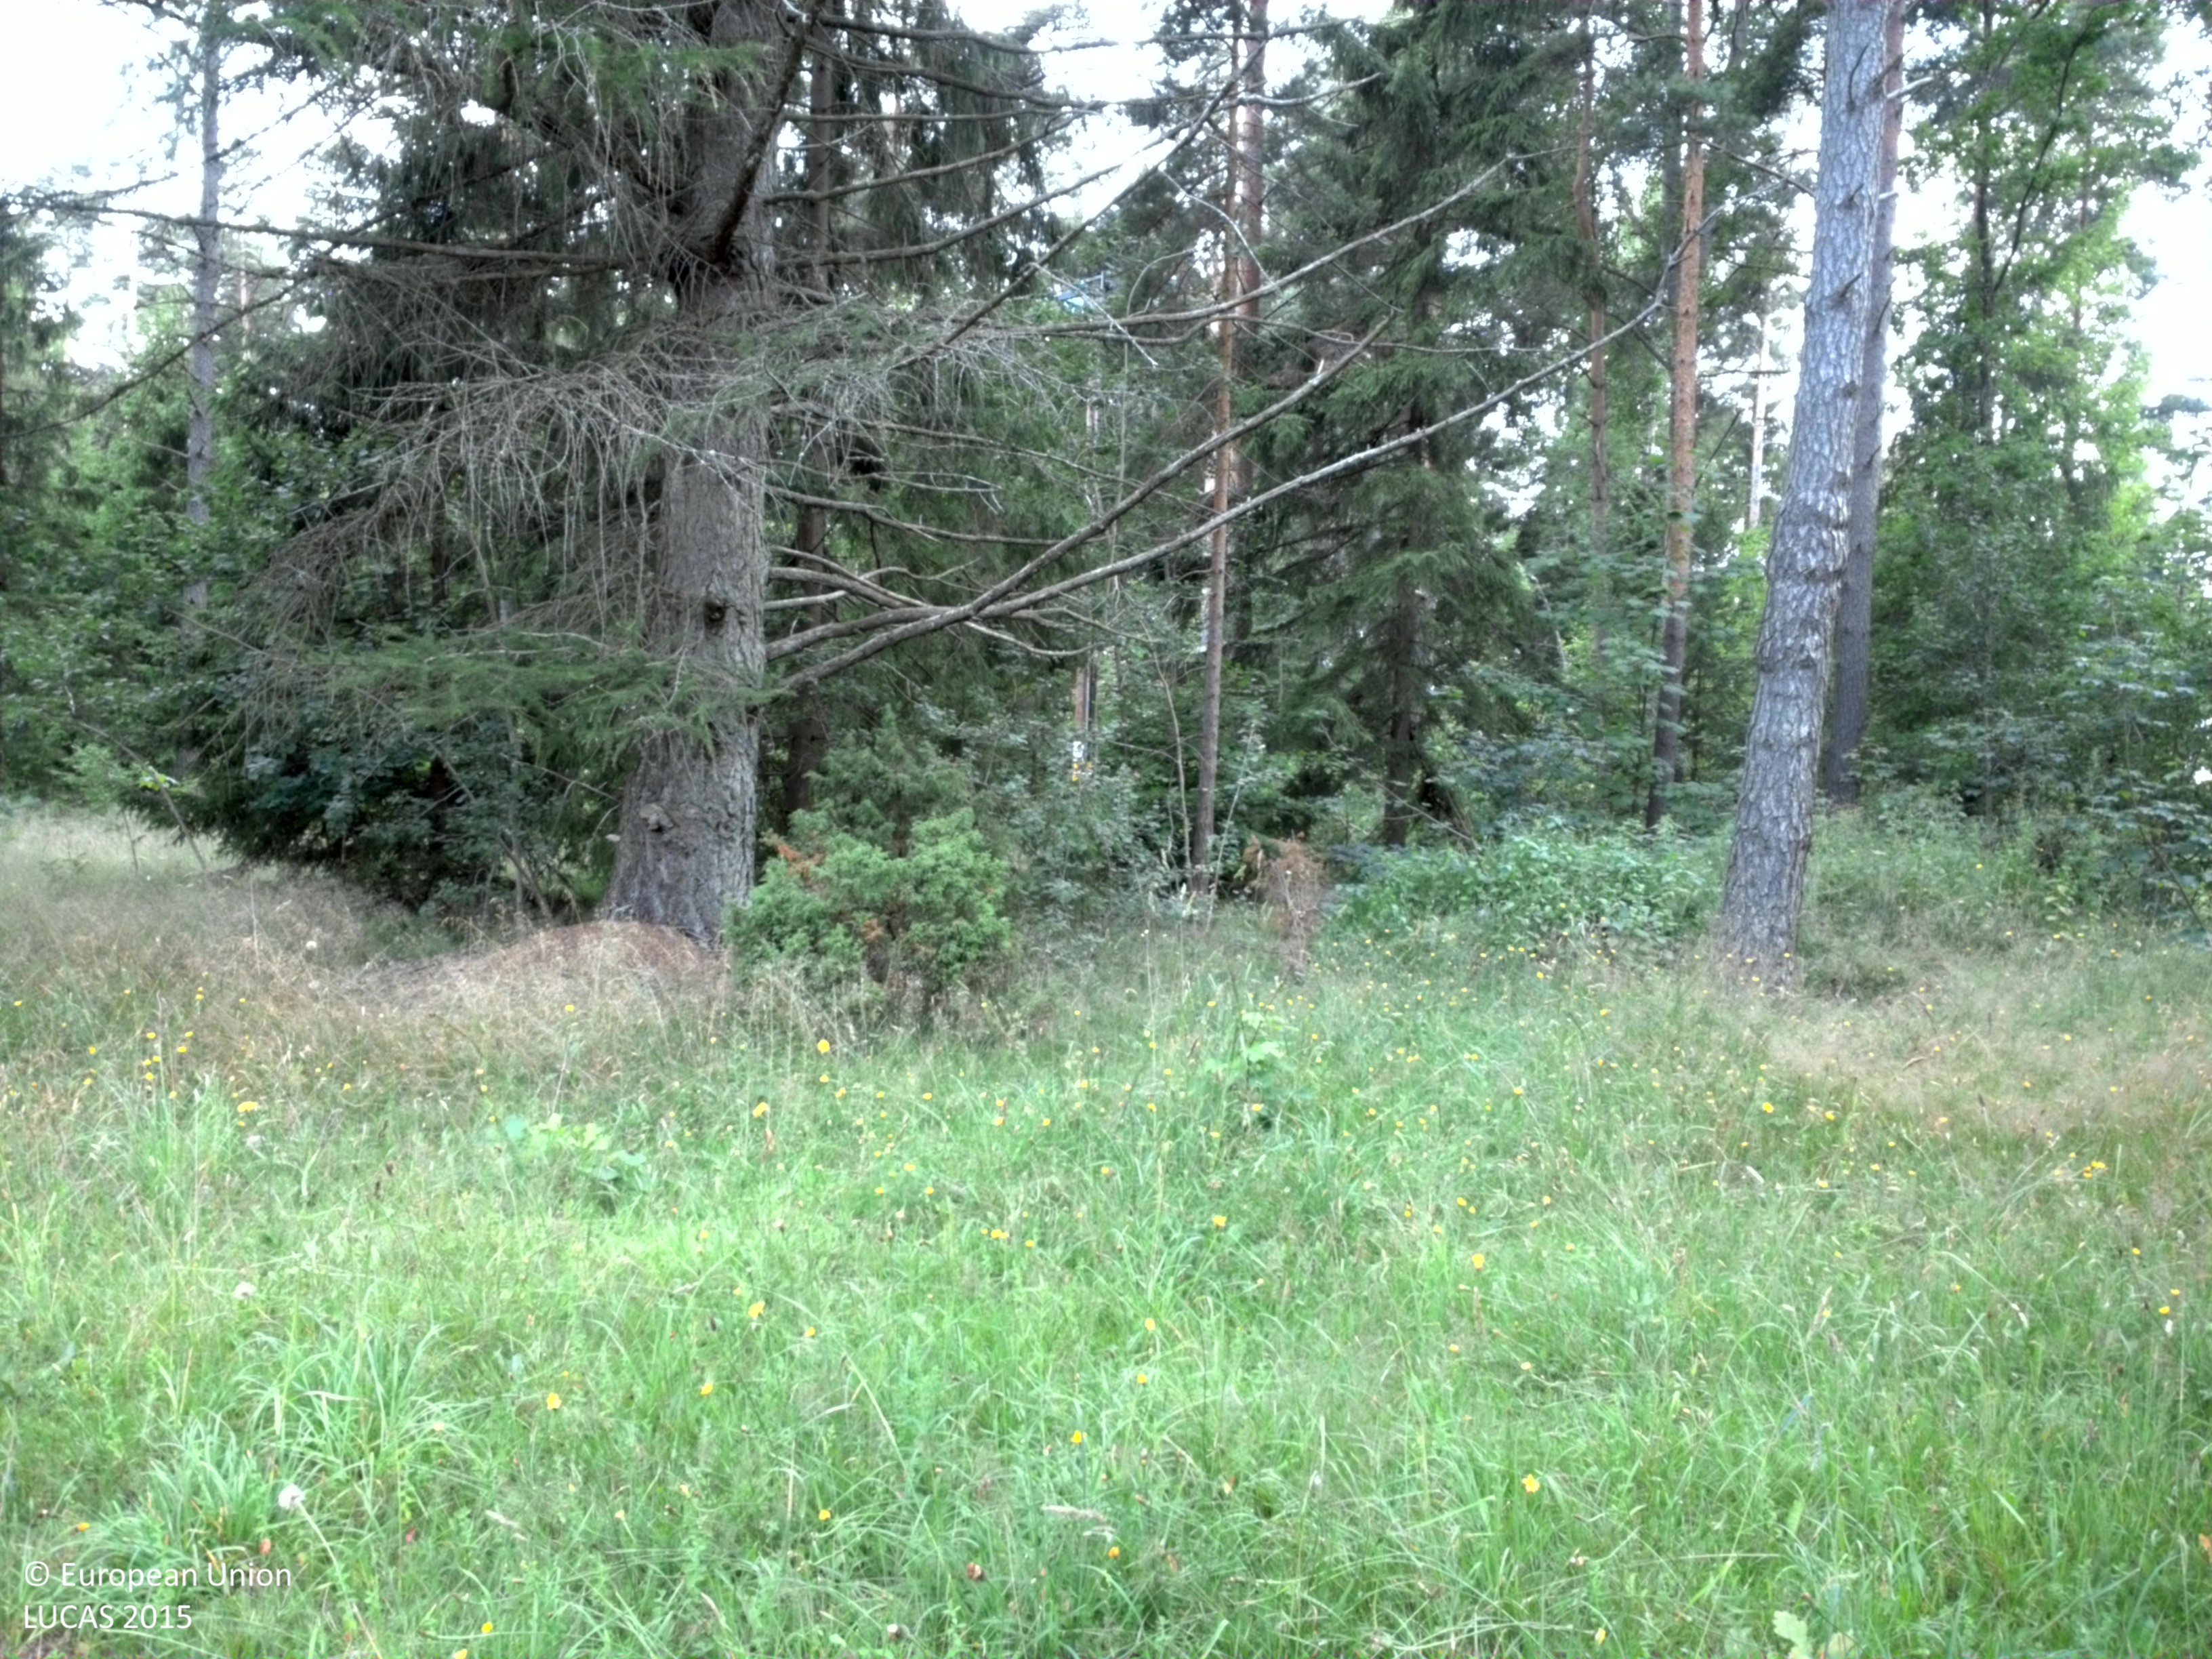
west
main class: Woodland
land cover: Pine dominated mixed woodland
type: hemiboreal forest and nemoral coniferous forest and mixed broadleaved-coniferous forest
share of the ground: > 75 %
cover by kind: coniferous forest trees 55 %, broadleaved forest trees 20 %, herbaceous plants 15 %, shrubs 10 %
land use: Forestry
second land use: Amenities, museums, leisure
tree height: > 5 m
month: July
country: SE
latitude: 57.4440
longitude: 18.4896
